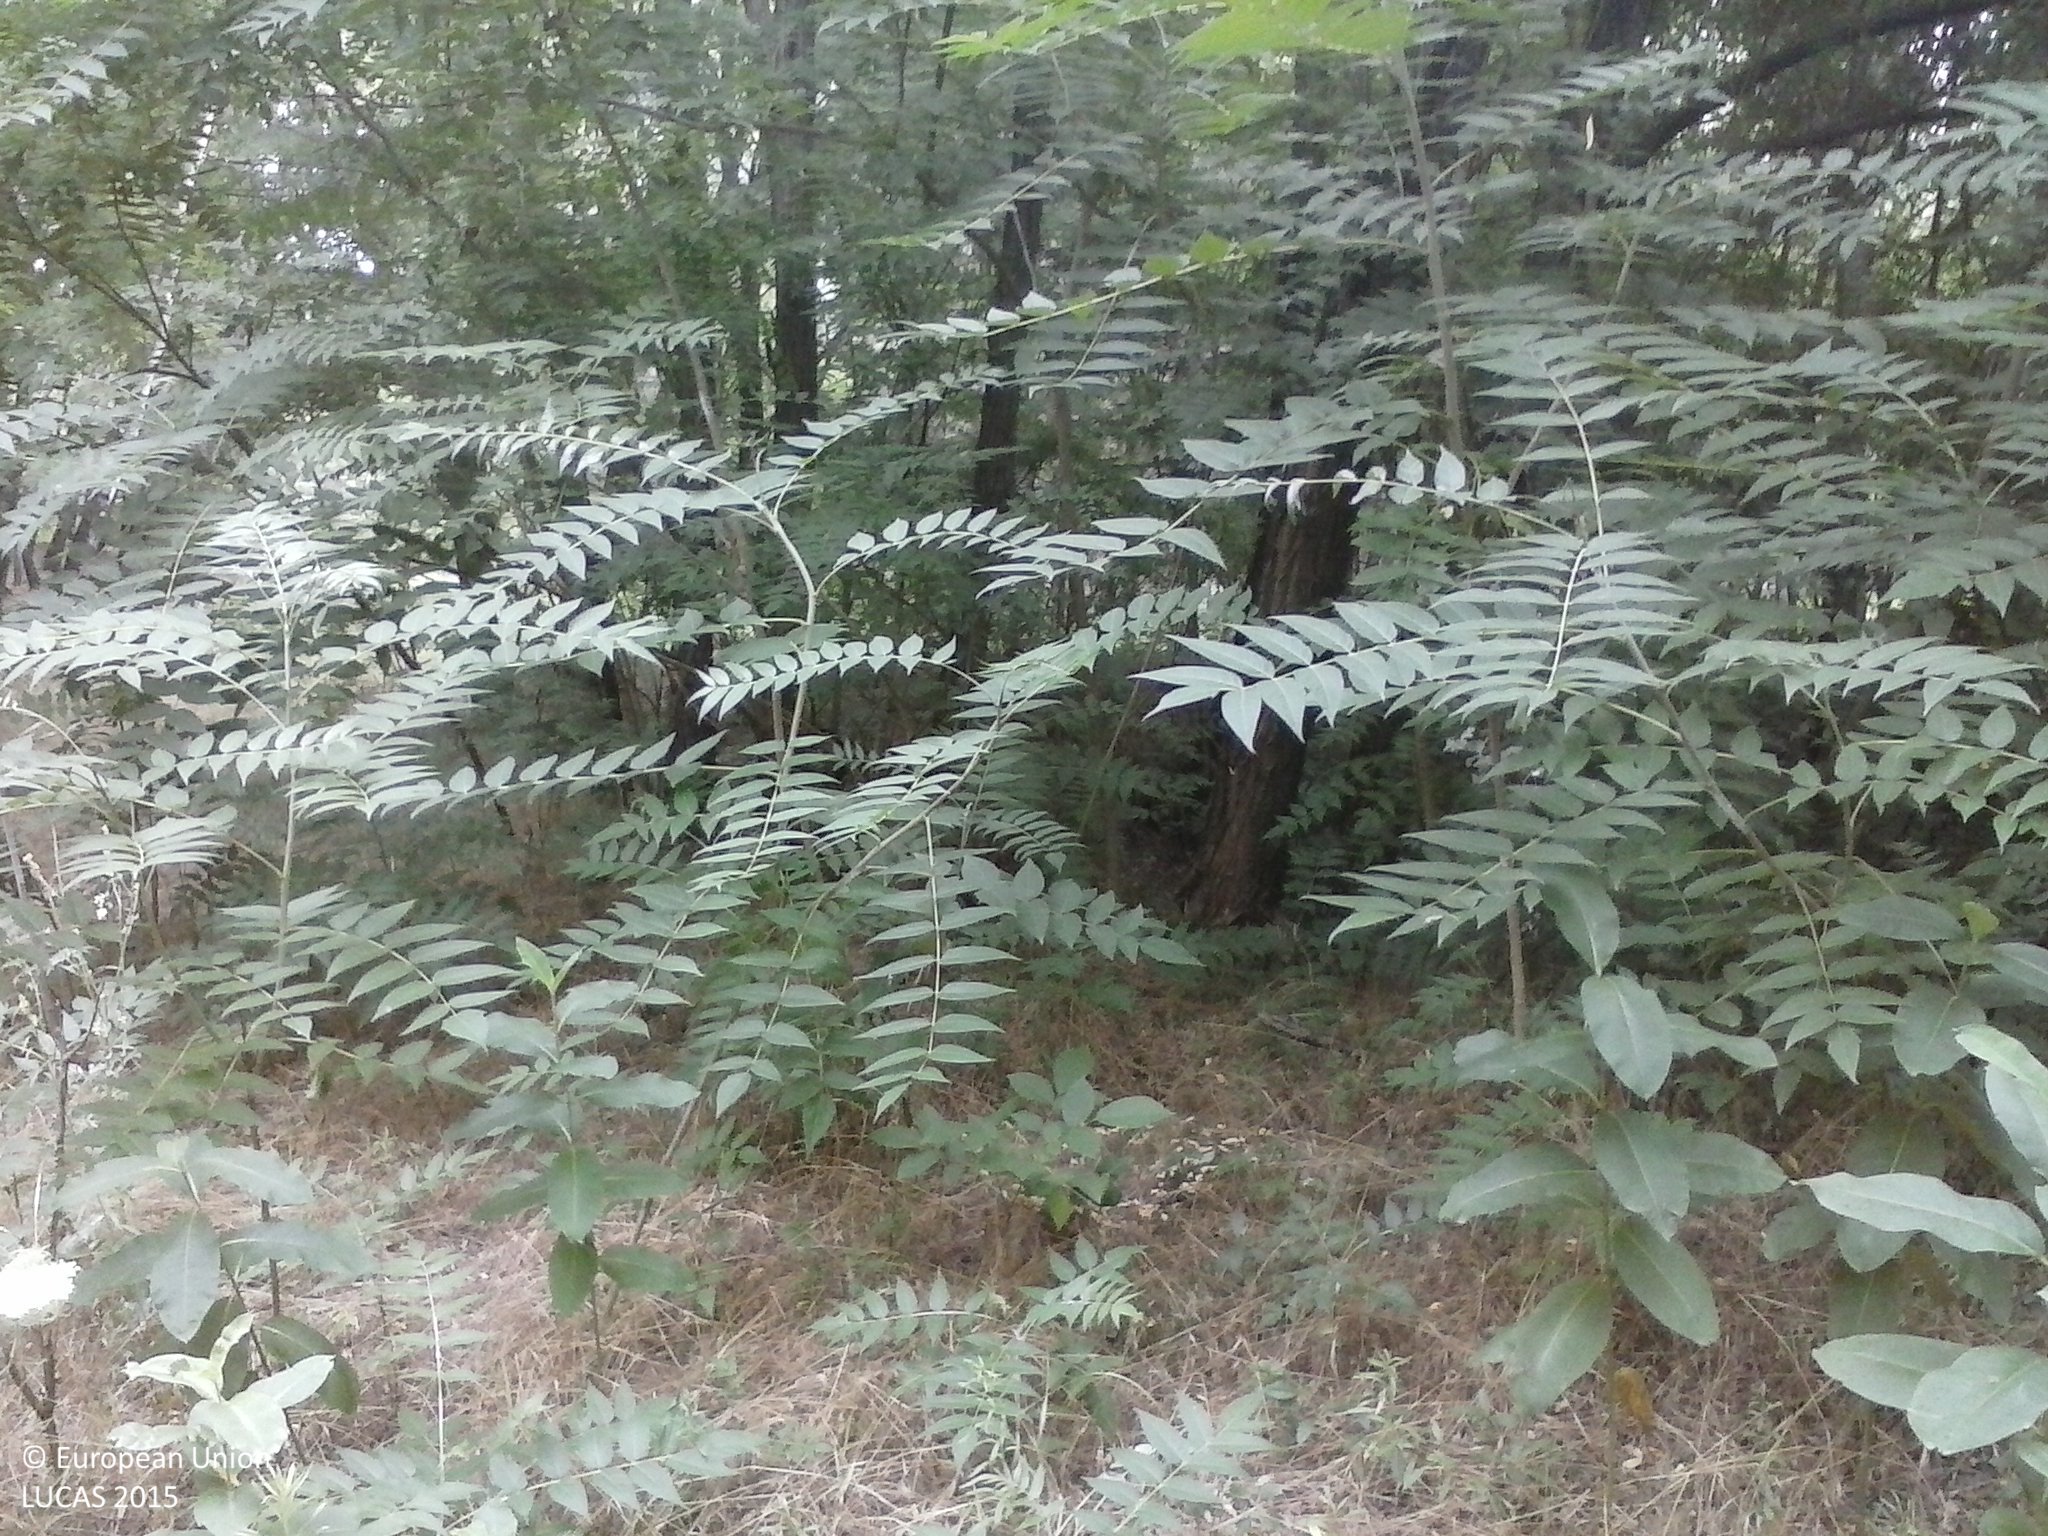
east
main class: Woodland
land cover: Broadleaved woodland
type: exotic forest
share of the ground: > 75 %
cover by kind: broadleaved forest trees 85 %, herbaceous plants 10 %, shrubs 5 %
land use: Forestry
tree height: > 5 m
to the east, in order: Broadleaved woodland; Spruce dominated coniferous woodland; Broadleaved woodland; Spruce dominated coniferous woodland; Broadleaved woodland
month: July
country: HU
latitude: 46.4704
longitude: 19.5113
